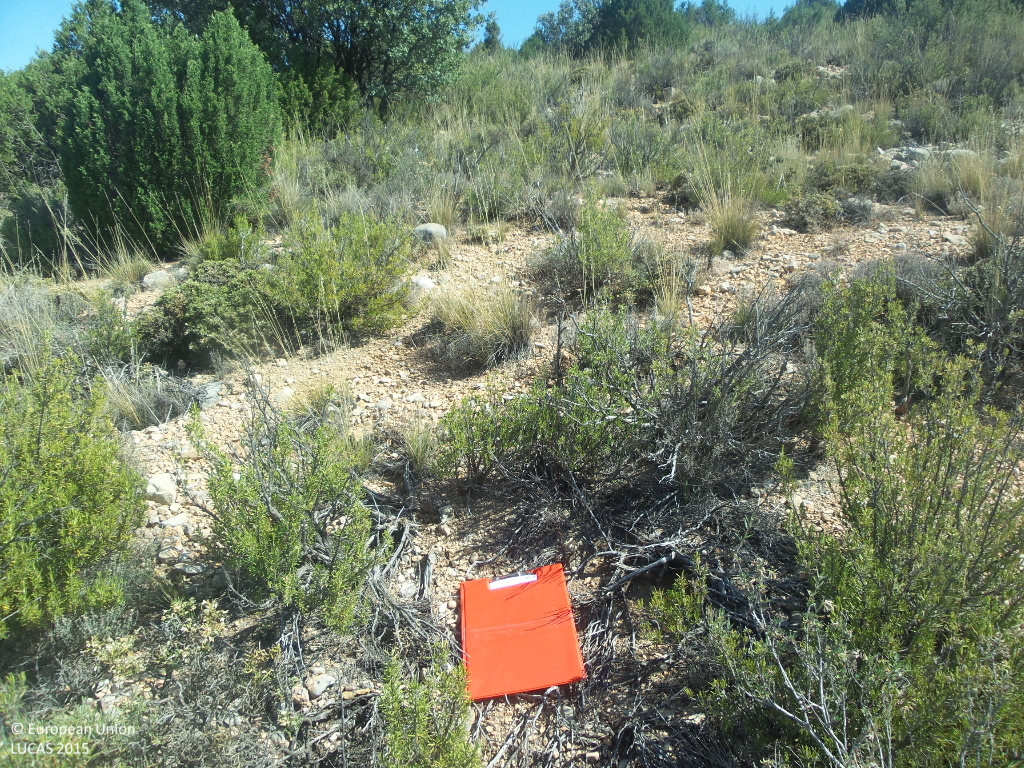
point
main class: Shrubland
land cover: Shrubland without tree cover
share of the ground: 50 - 75 %
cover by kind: shrubs 60 %, unconsolidated bare surface 35 %, herbaceous plants 5 %
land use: Semi-natural and natural areas not in use
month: July
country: ES
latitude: 41.1466
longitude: -1.9048
